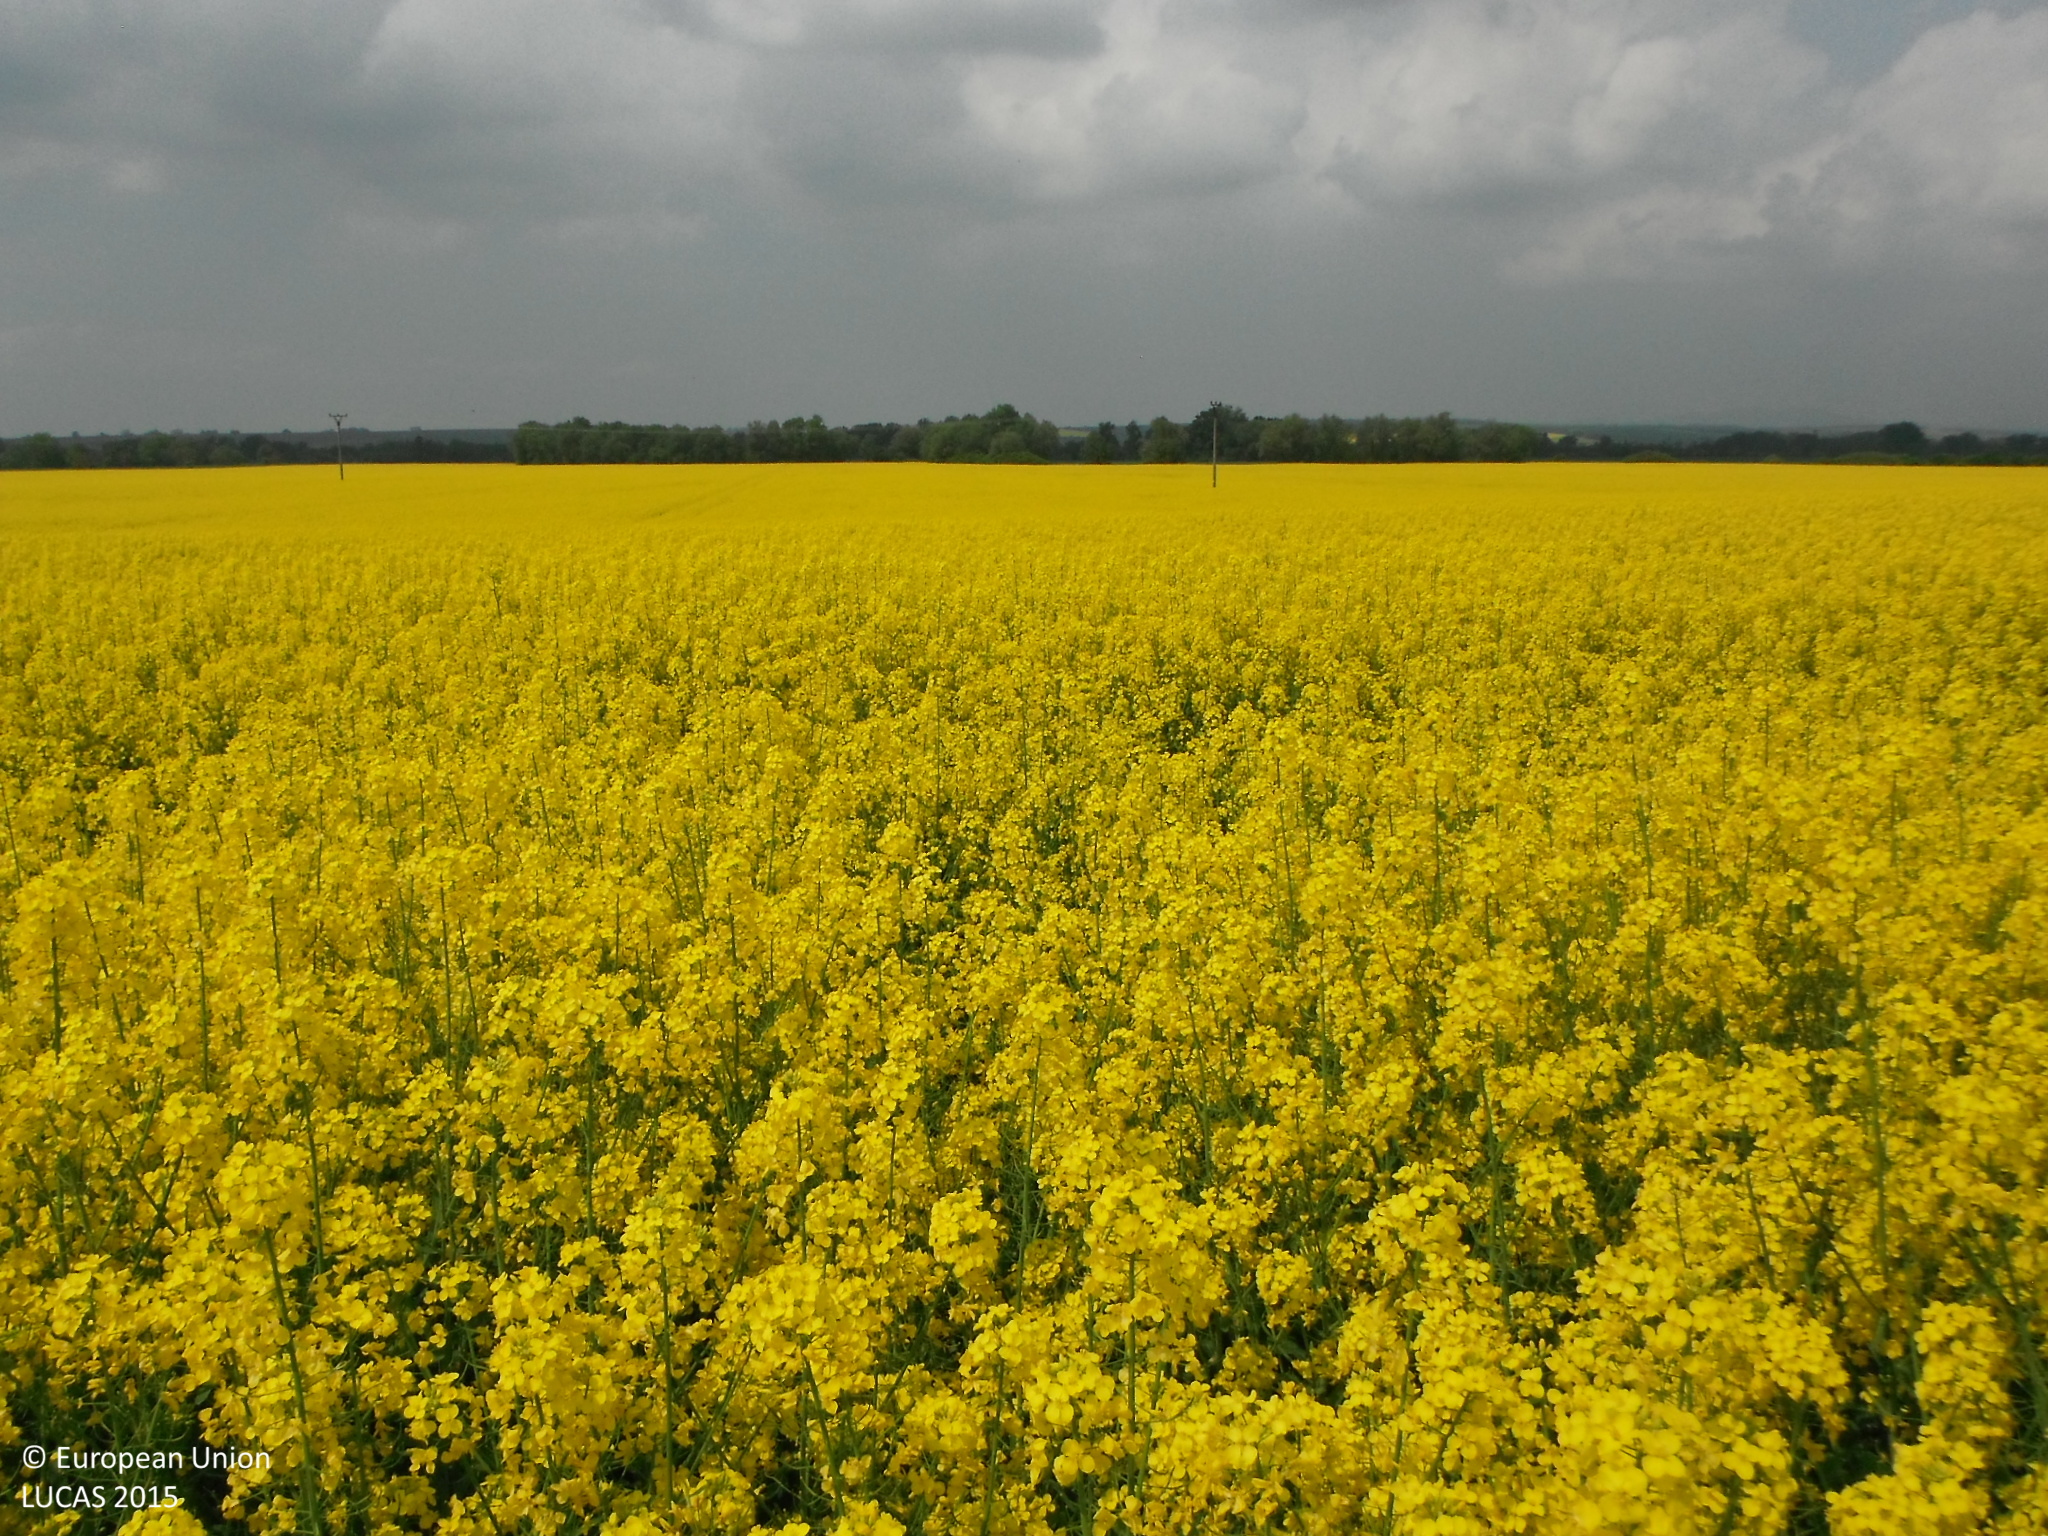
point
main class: Cropland
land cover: Rape and turnip rape
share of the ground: > 75 %
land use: Agriculture (excluding fallow land and kitchen gardens)
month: May
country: SK
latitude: 48.3950
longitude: 18.1039
